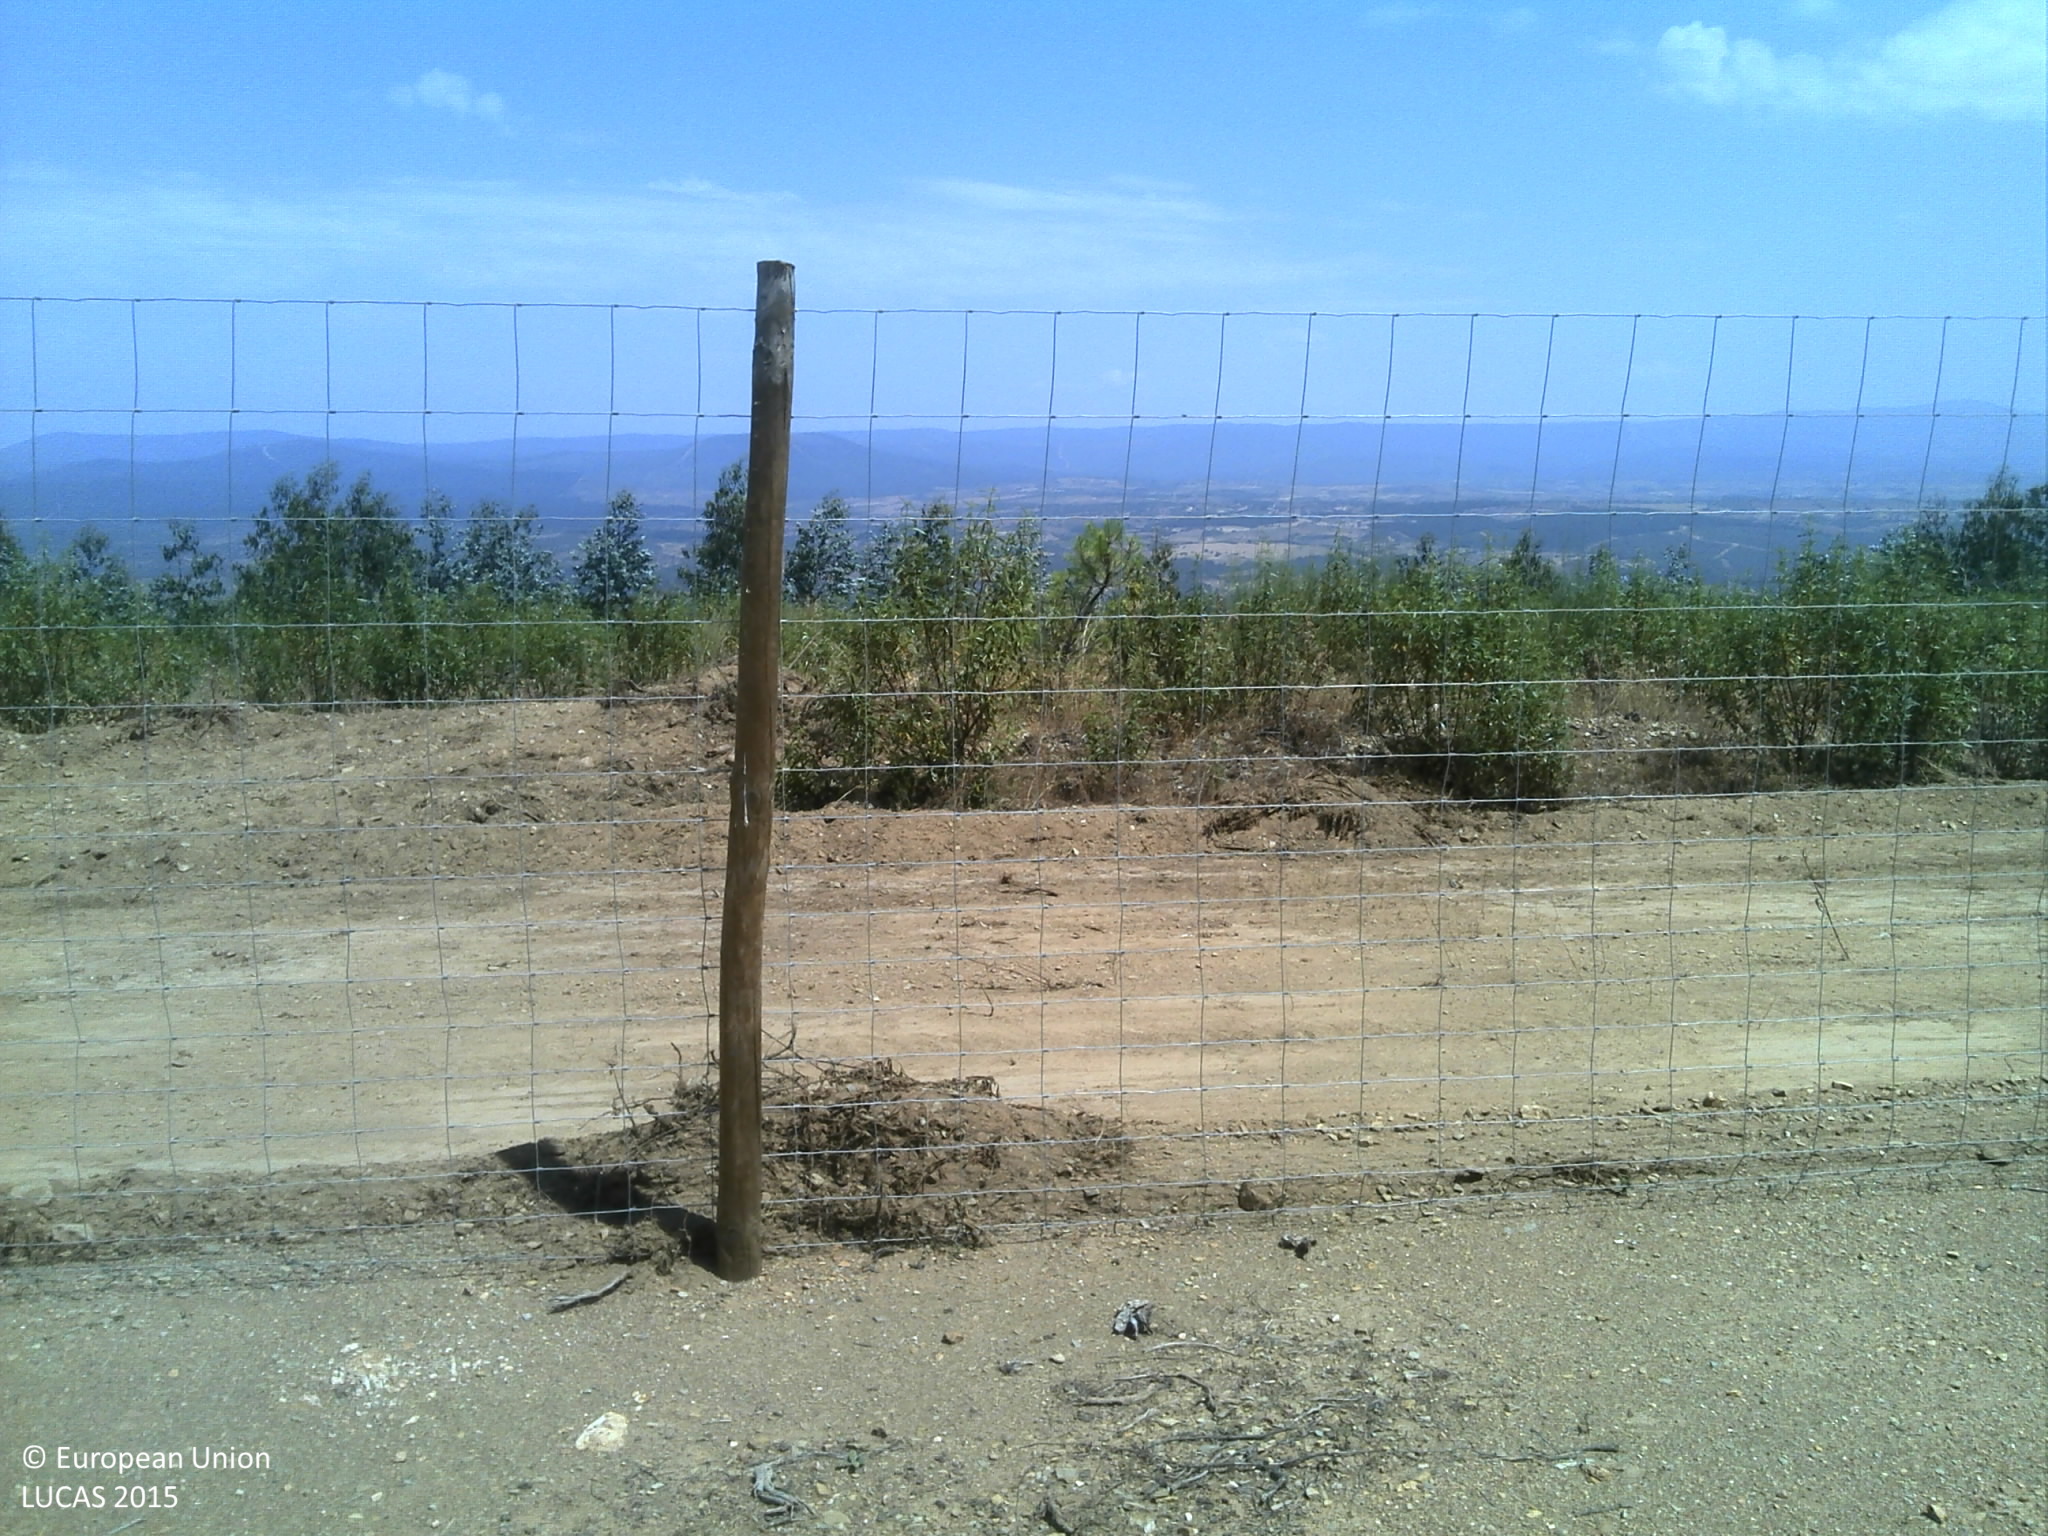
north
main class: Woodland
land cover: Pine dominated coniferous woodland
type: coniferous forest of the mediterranean region
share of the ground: > 75 %
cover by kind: coniferous forest trees 75 %, unconsolidated bare surface 25 %
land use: Forestry
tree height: > 5 m
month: June
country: PT
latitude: 40.0781
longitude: -7.0137
